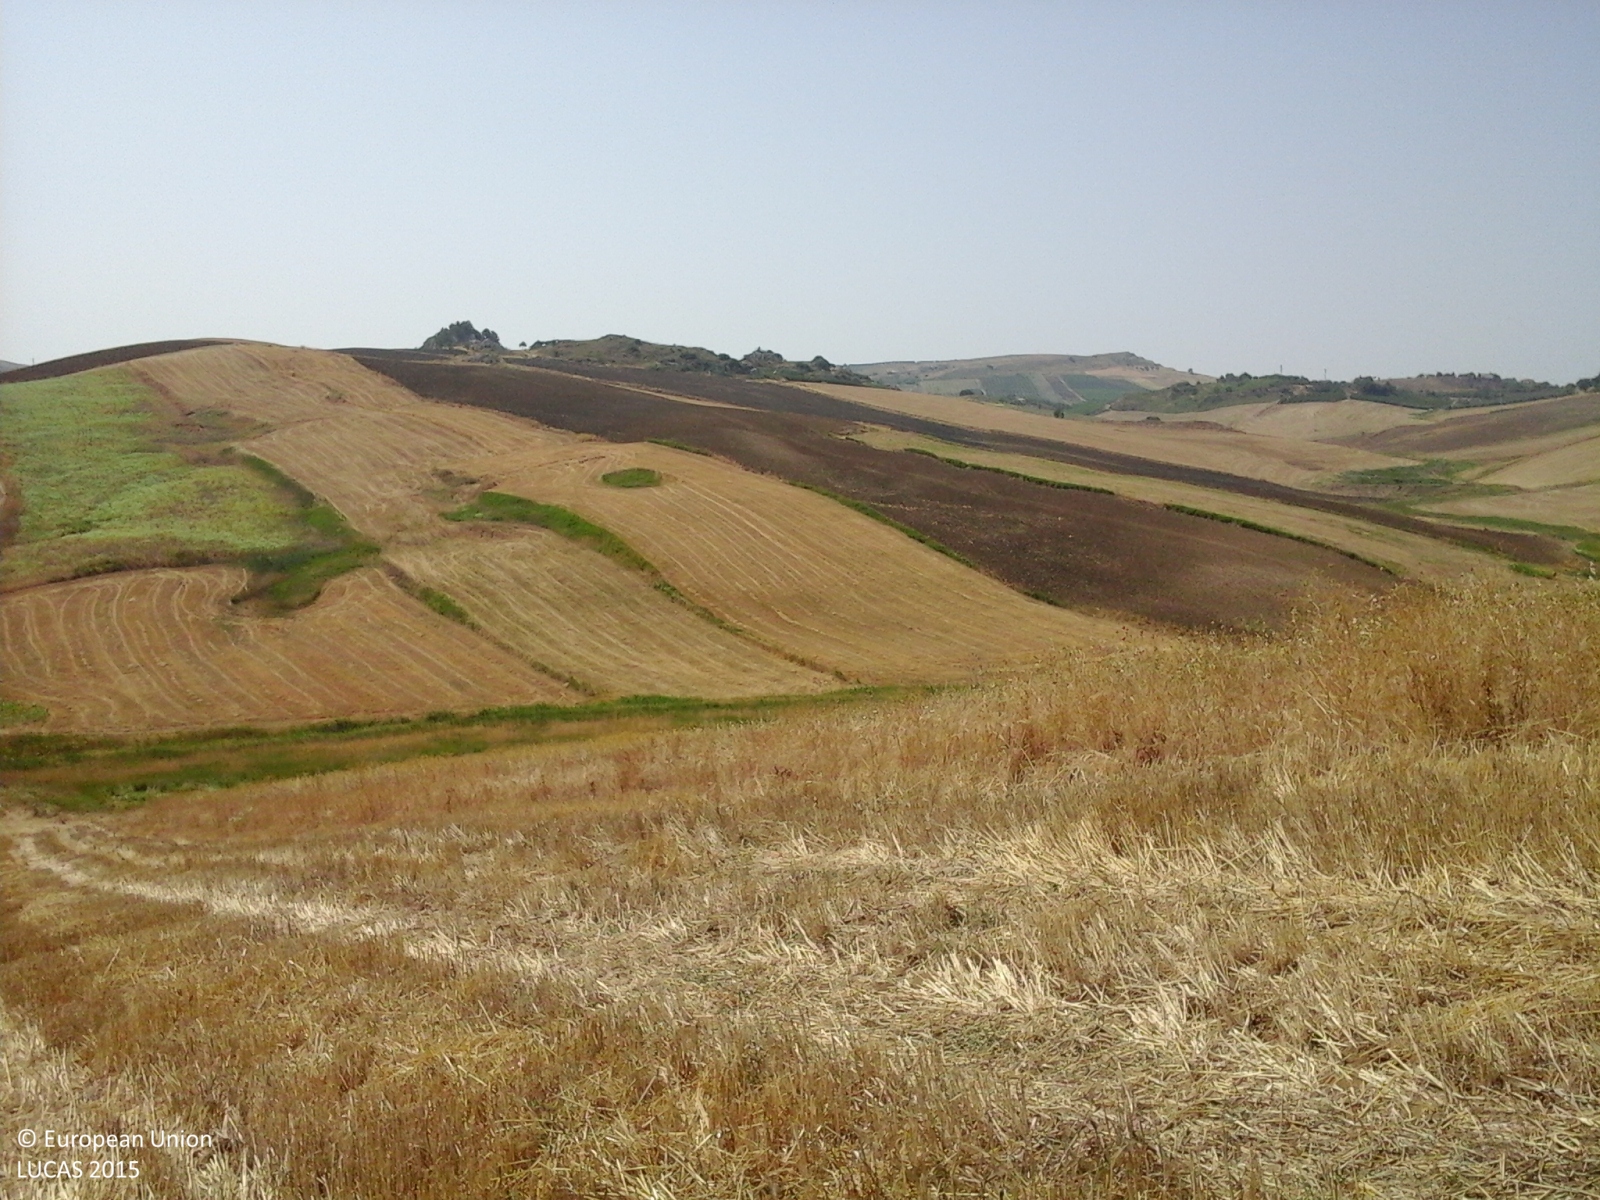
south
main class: Cropland
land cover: Durum wheat
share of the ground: > 75 %
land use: Agriculture (excluding fallow land and kitchen gardens)
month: July
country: IT
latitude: 37.3916
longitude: 13.9795
